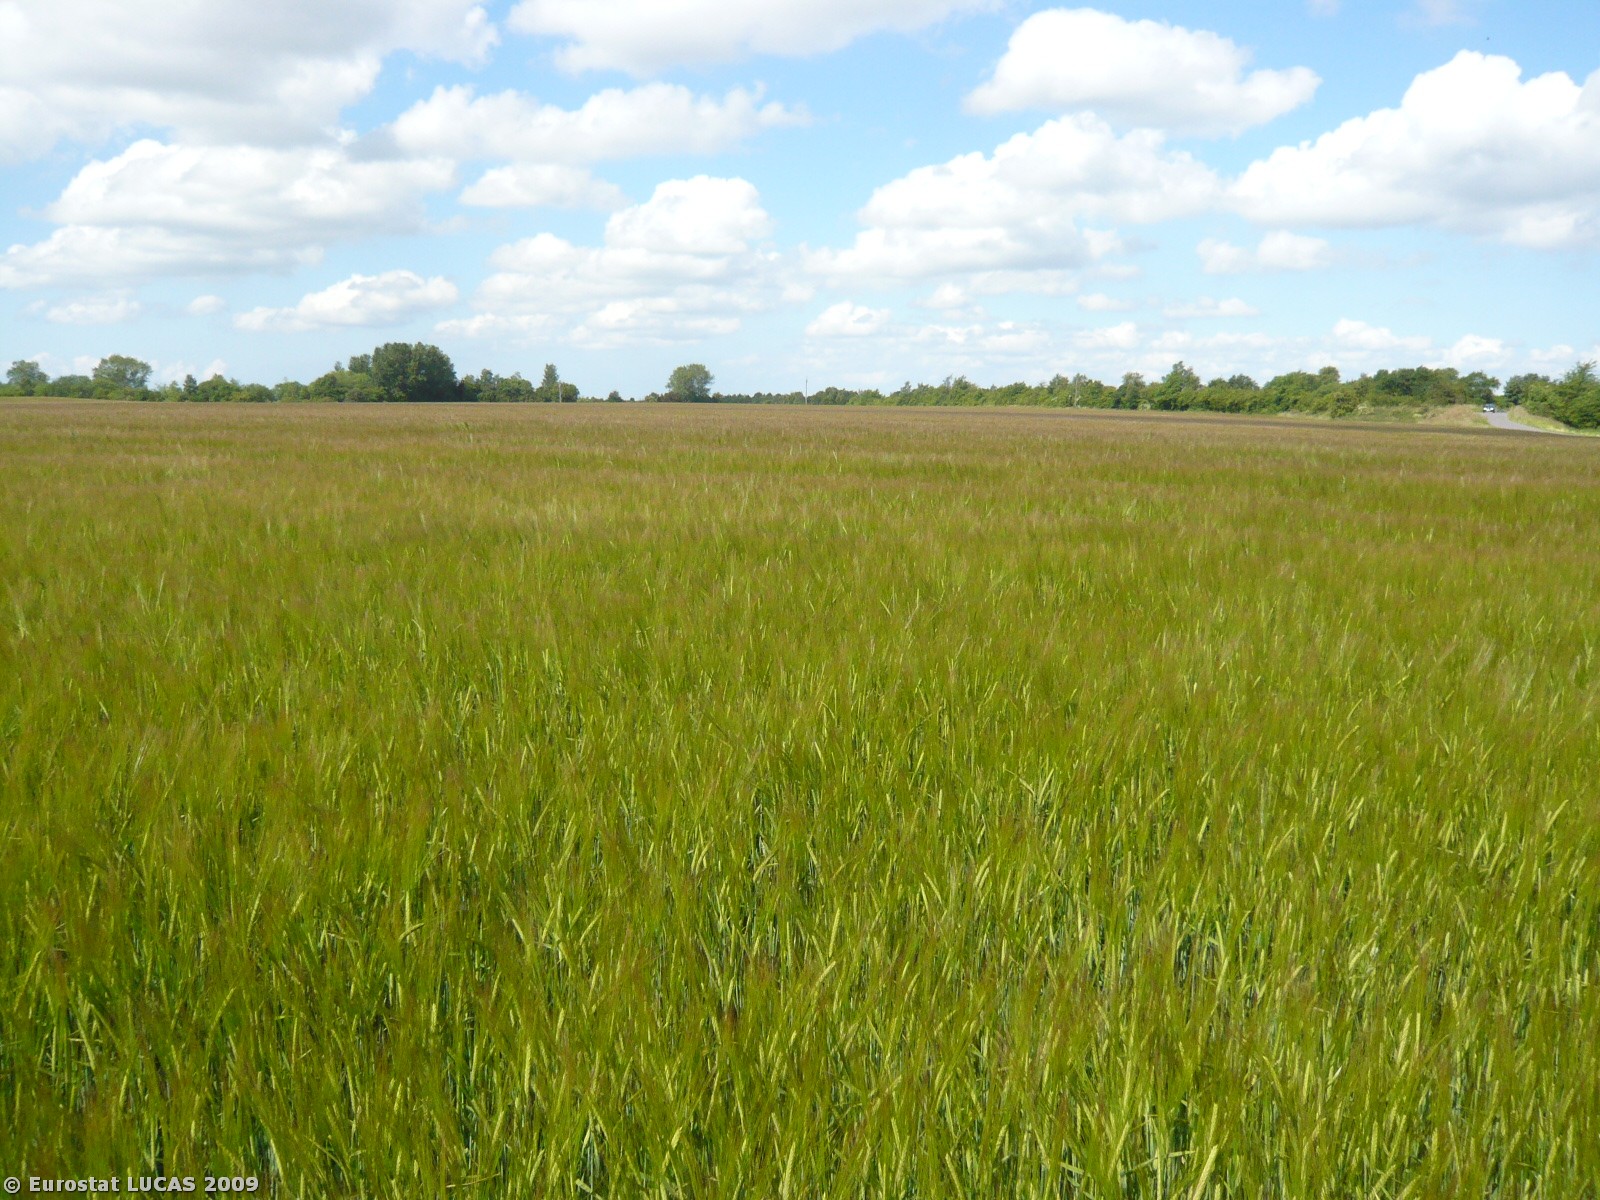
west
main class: Cropland
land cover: Barley
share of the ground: > 75 %
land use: Agriculture (excluding fallow land and kitchen gardens)
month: June
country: DK
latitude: 54.7208
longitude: 11.6601
